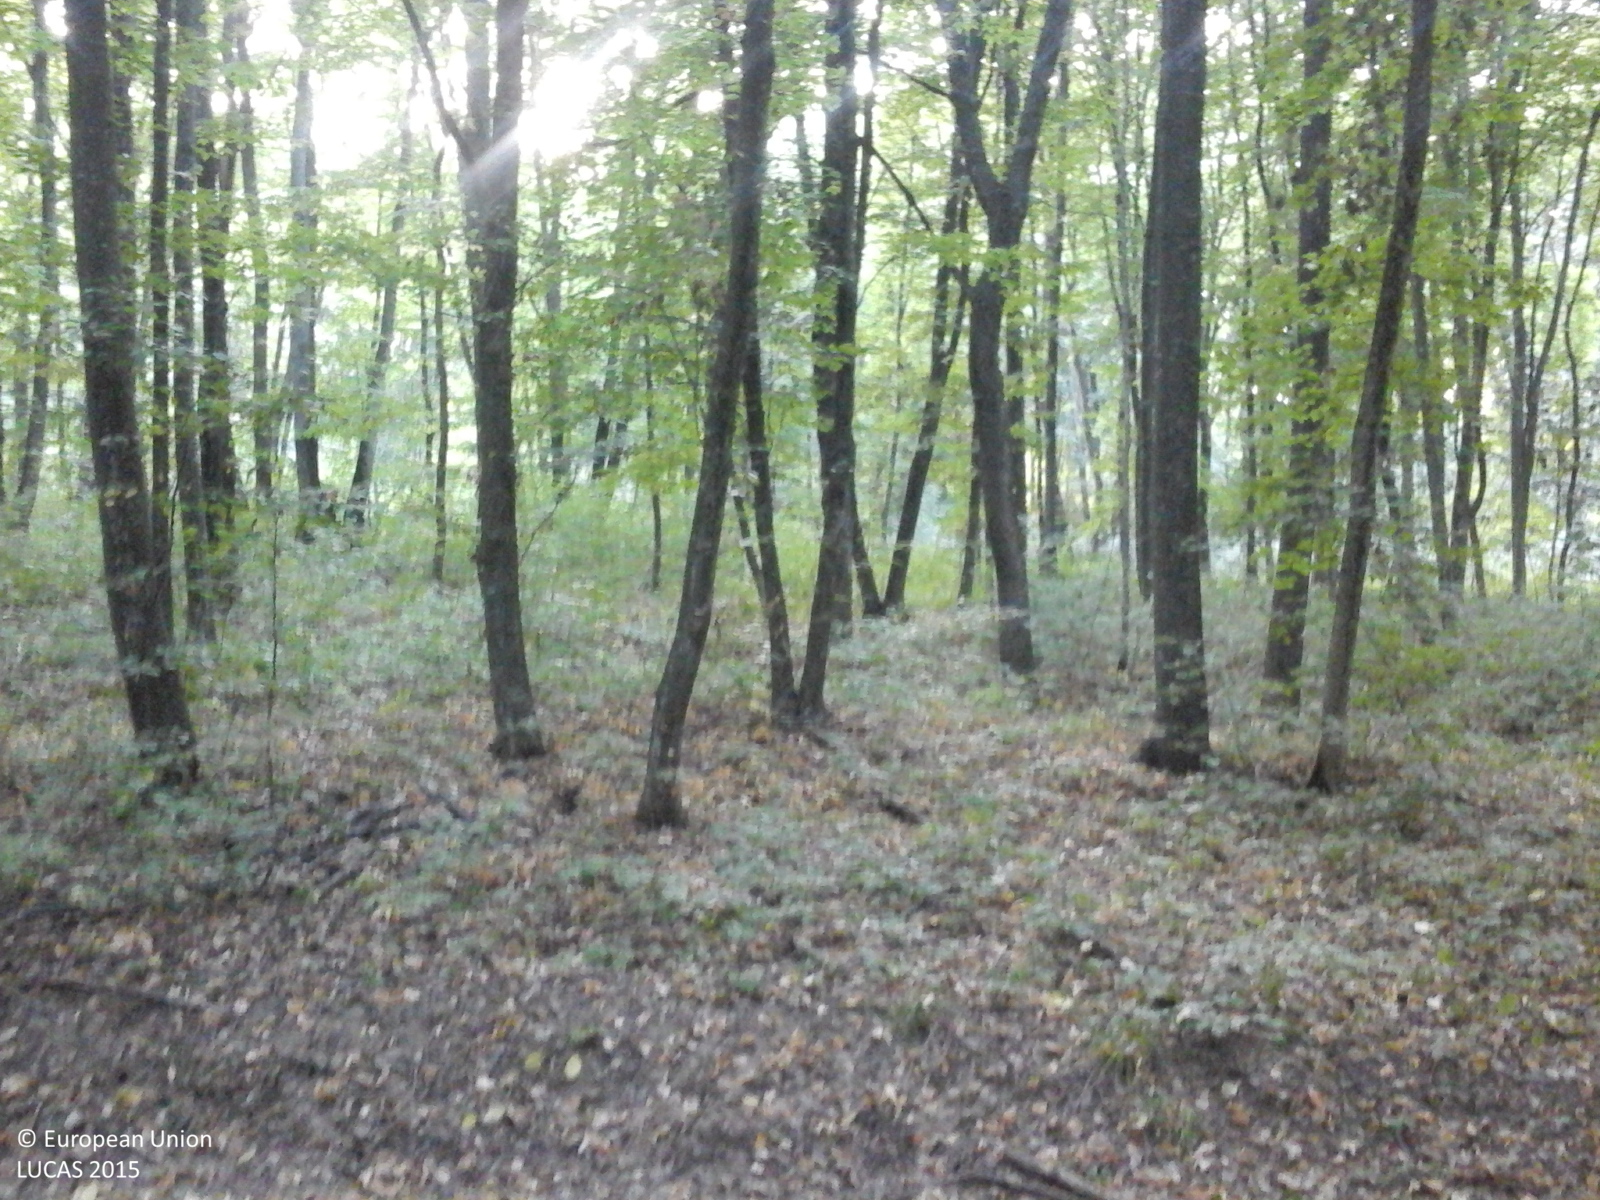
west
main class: Woodland
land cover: Broadleaved woodland
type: mesophytic deciduous forest
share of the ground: > 75 %
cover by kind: broadleaved forest trees 100 %
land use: Forestry
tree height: > 5 m
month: July
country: RO
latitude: 45.1818
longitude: 28.3892
